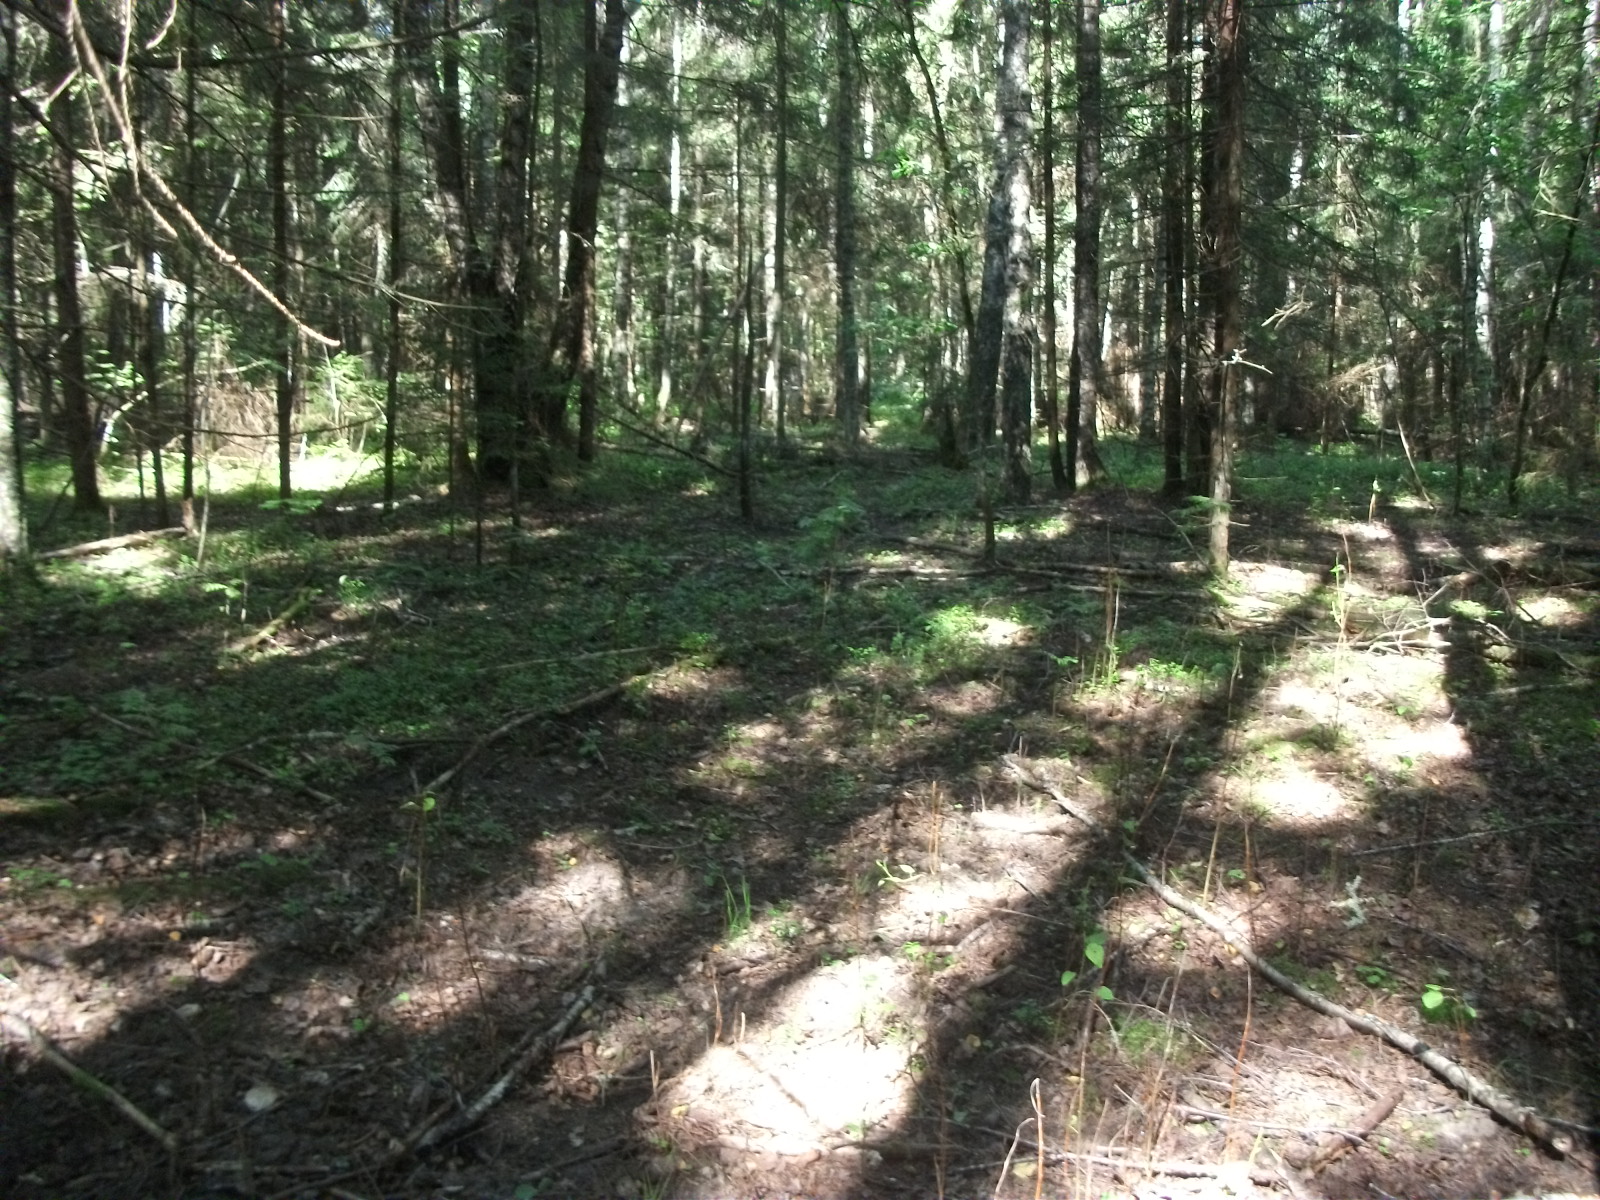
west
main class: Woodland
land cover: Spruce dominated mixed woodland
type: hemiboreal forest and nemoral coniferous forest and mixed broadleaved-coniferous forest
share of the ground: > 75 %
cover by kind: coniferous forest trees 50 %, broadleaved forest trees 35 %, lichens and mosses 10 %, herbaceous plants 5 %
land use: Forestry
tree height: > 5 m
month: August
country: LV
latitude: 57.0481
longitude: 26.4461
